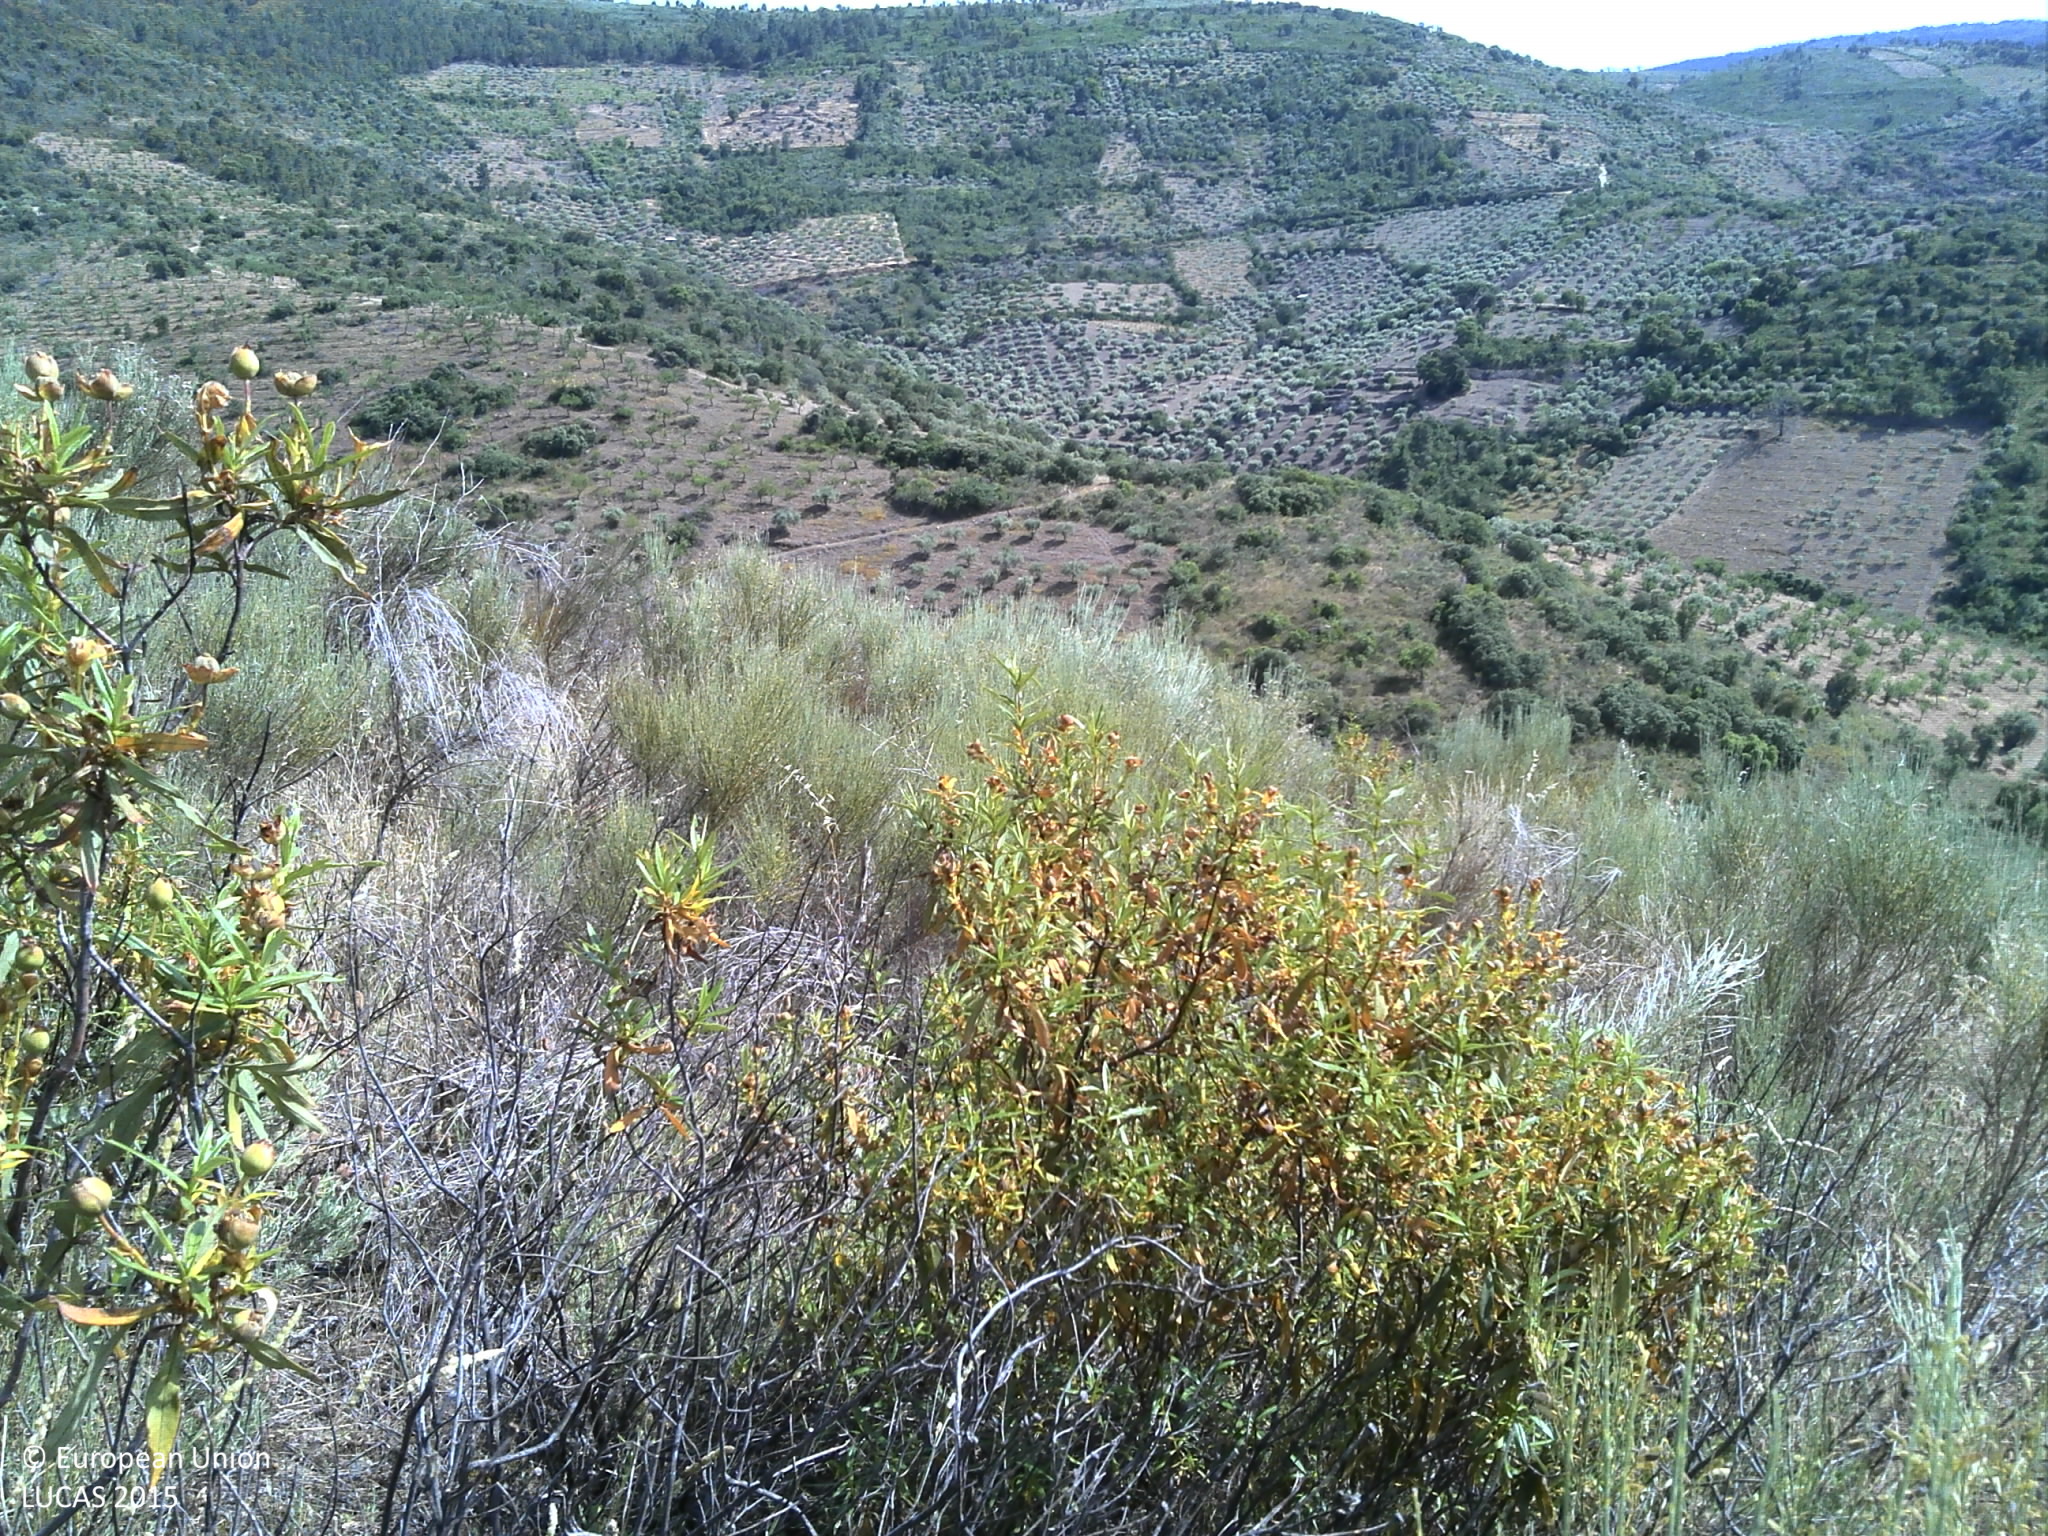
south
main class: Shrubland
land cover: Shrubland with sparse tree cover
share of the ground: 50 - 75 %
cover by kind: shrubs 75 %, unconsolidated bare surface 15 %, broadleaved forest trees 5 %, herbaceous plants 5 %
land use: Abandoned areas
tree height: < 5 m
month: May
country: PT
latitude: 41.2327
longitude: -6.9431
